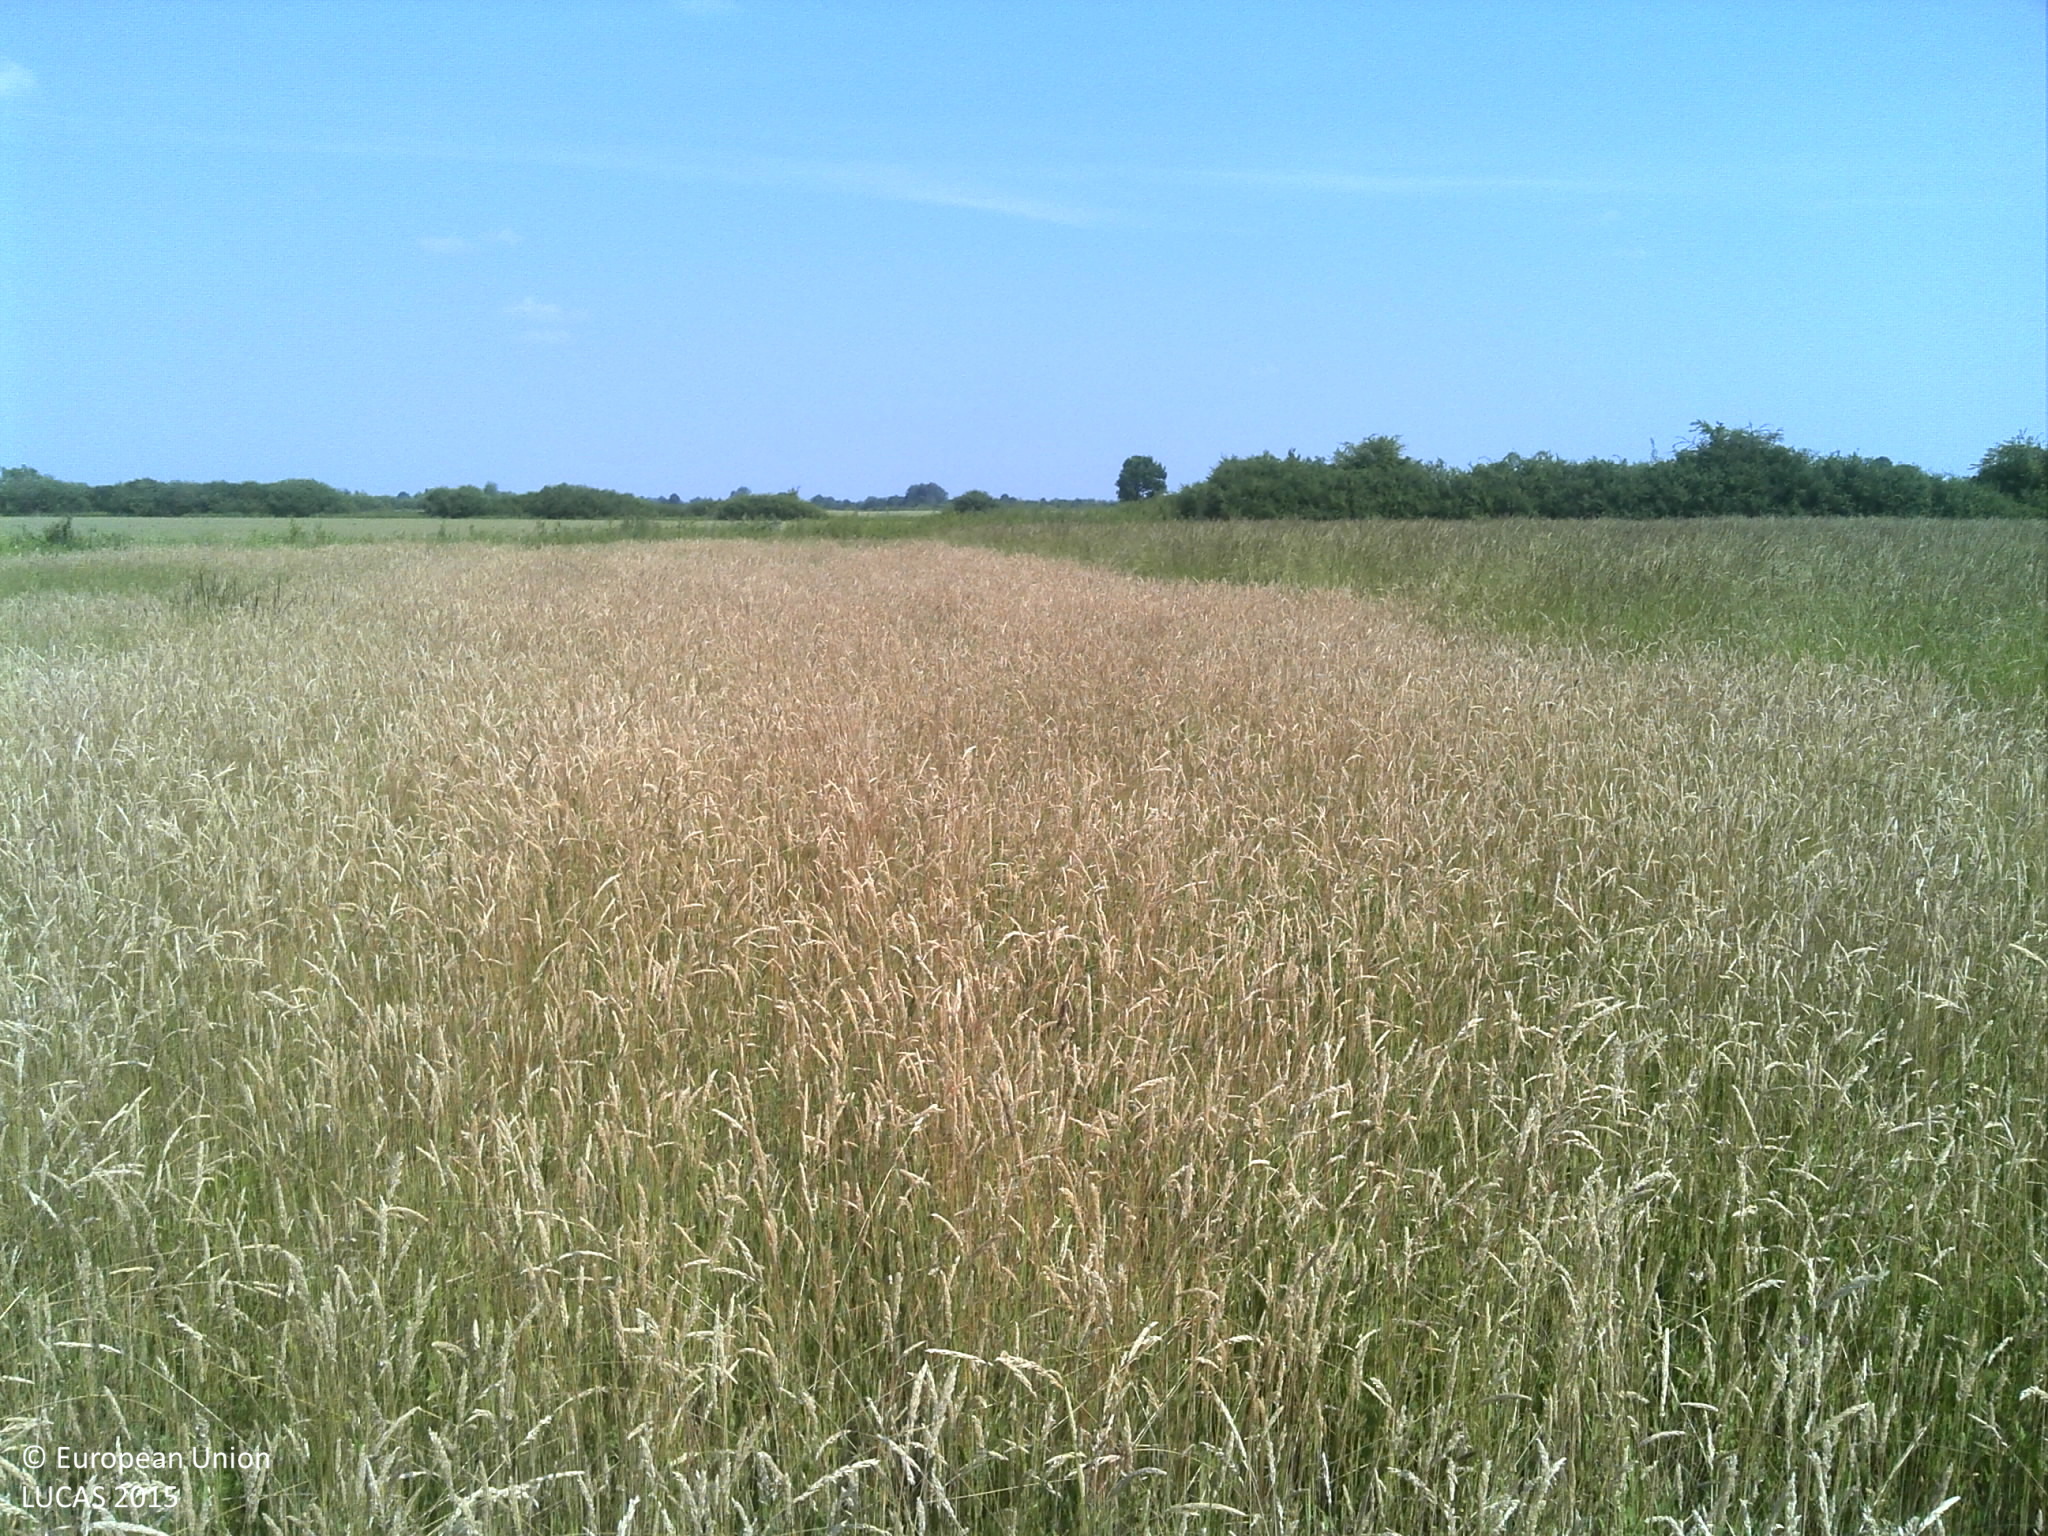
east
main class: Grassland
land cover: Spontaneously vegetated surfaces
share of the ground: > 75 %
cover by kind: herbaceous plants 100 %
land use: Fallow land
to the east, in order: Spontaneously vegetated surfaces; Ditches and canals; Tracks; Soya
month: June
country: HR
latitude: 45.7004
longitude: 17.8511
